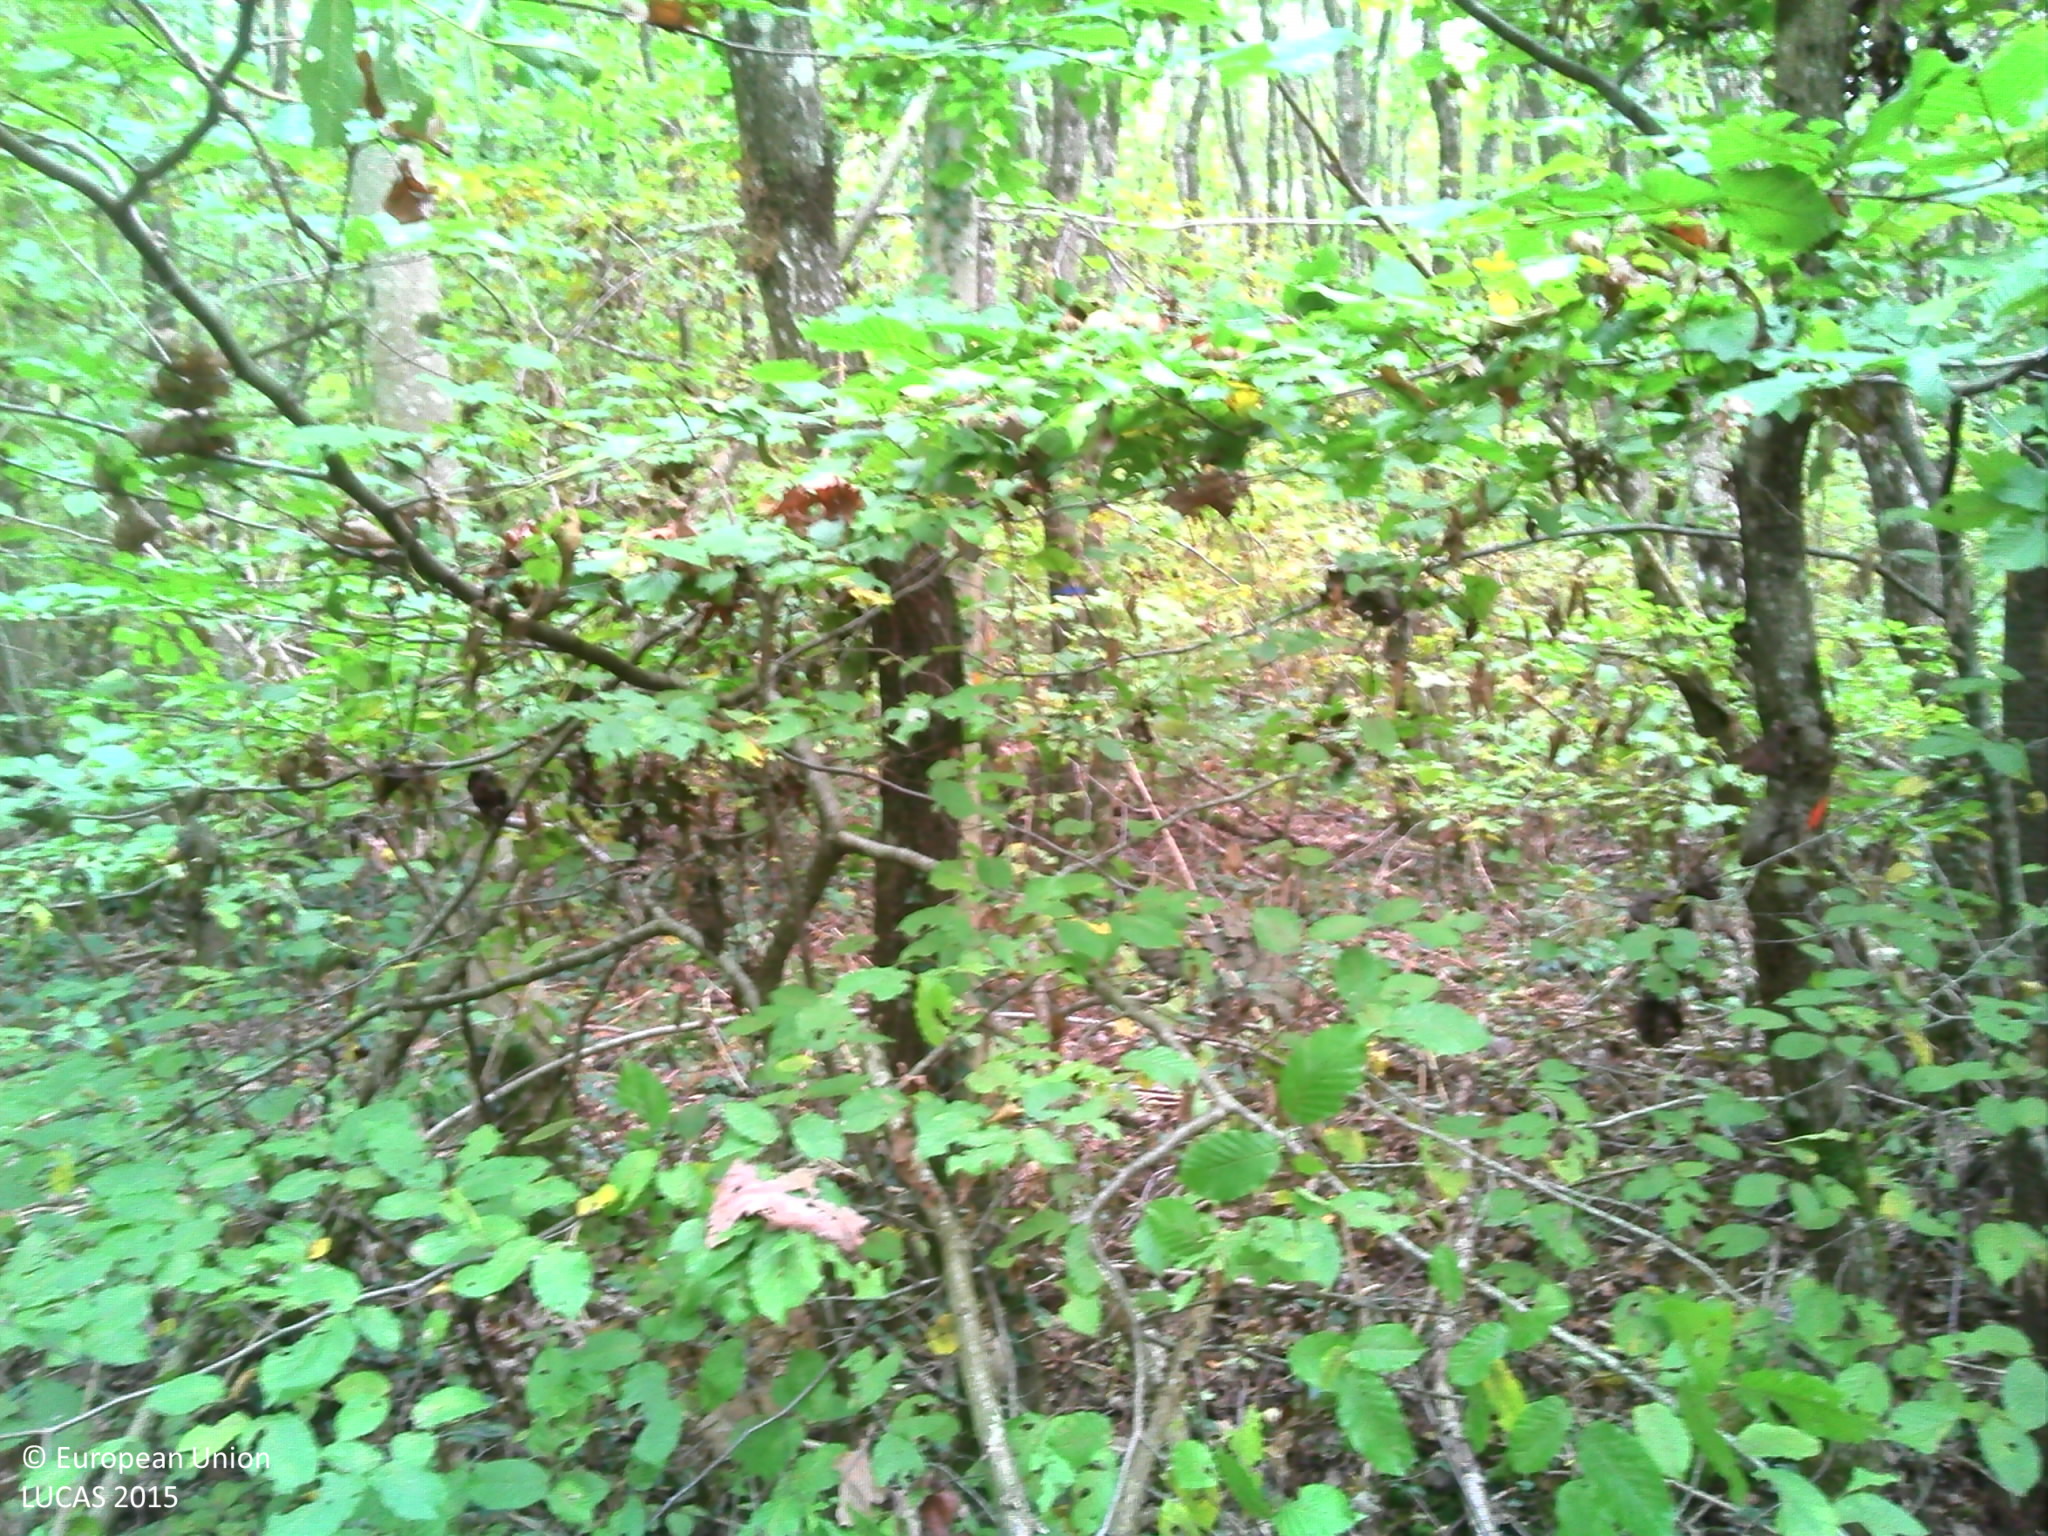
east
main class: Woodland
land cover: Broadleaved woodland
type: mesophytic deciduous forest
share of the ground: > 75 %
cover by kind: broadleaved forest trees 100 %
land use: Forestry
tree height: > 5 m
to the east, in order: Broadleaved woodland
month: October
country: FR
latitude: 47.5514
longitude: 5.4162
